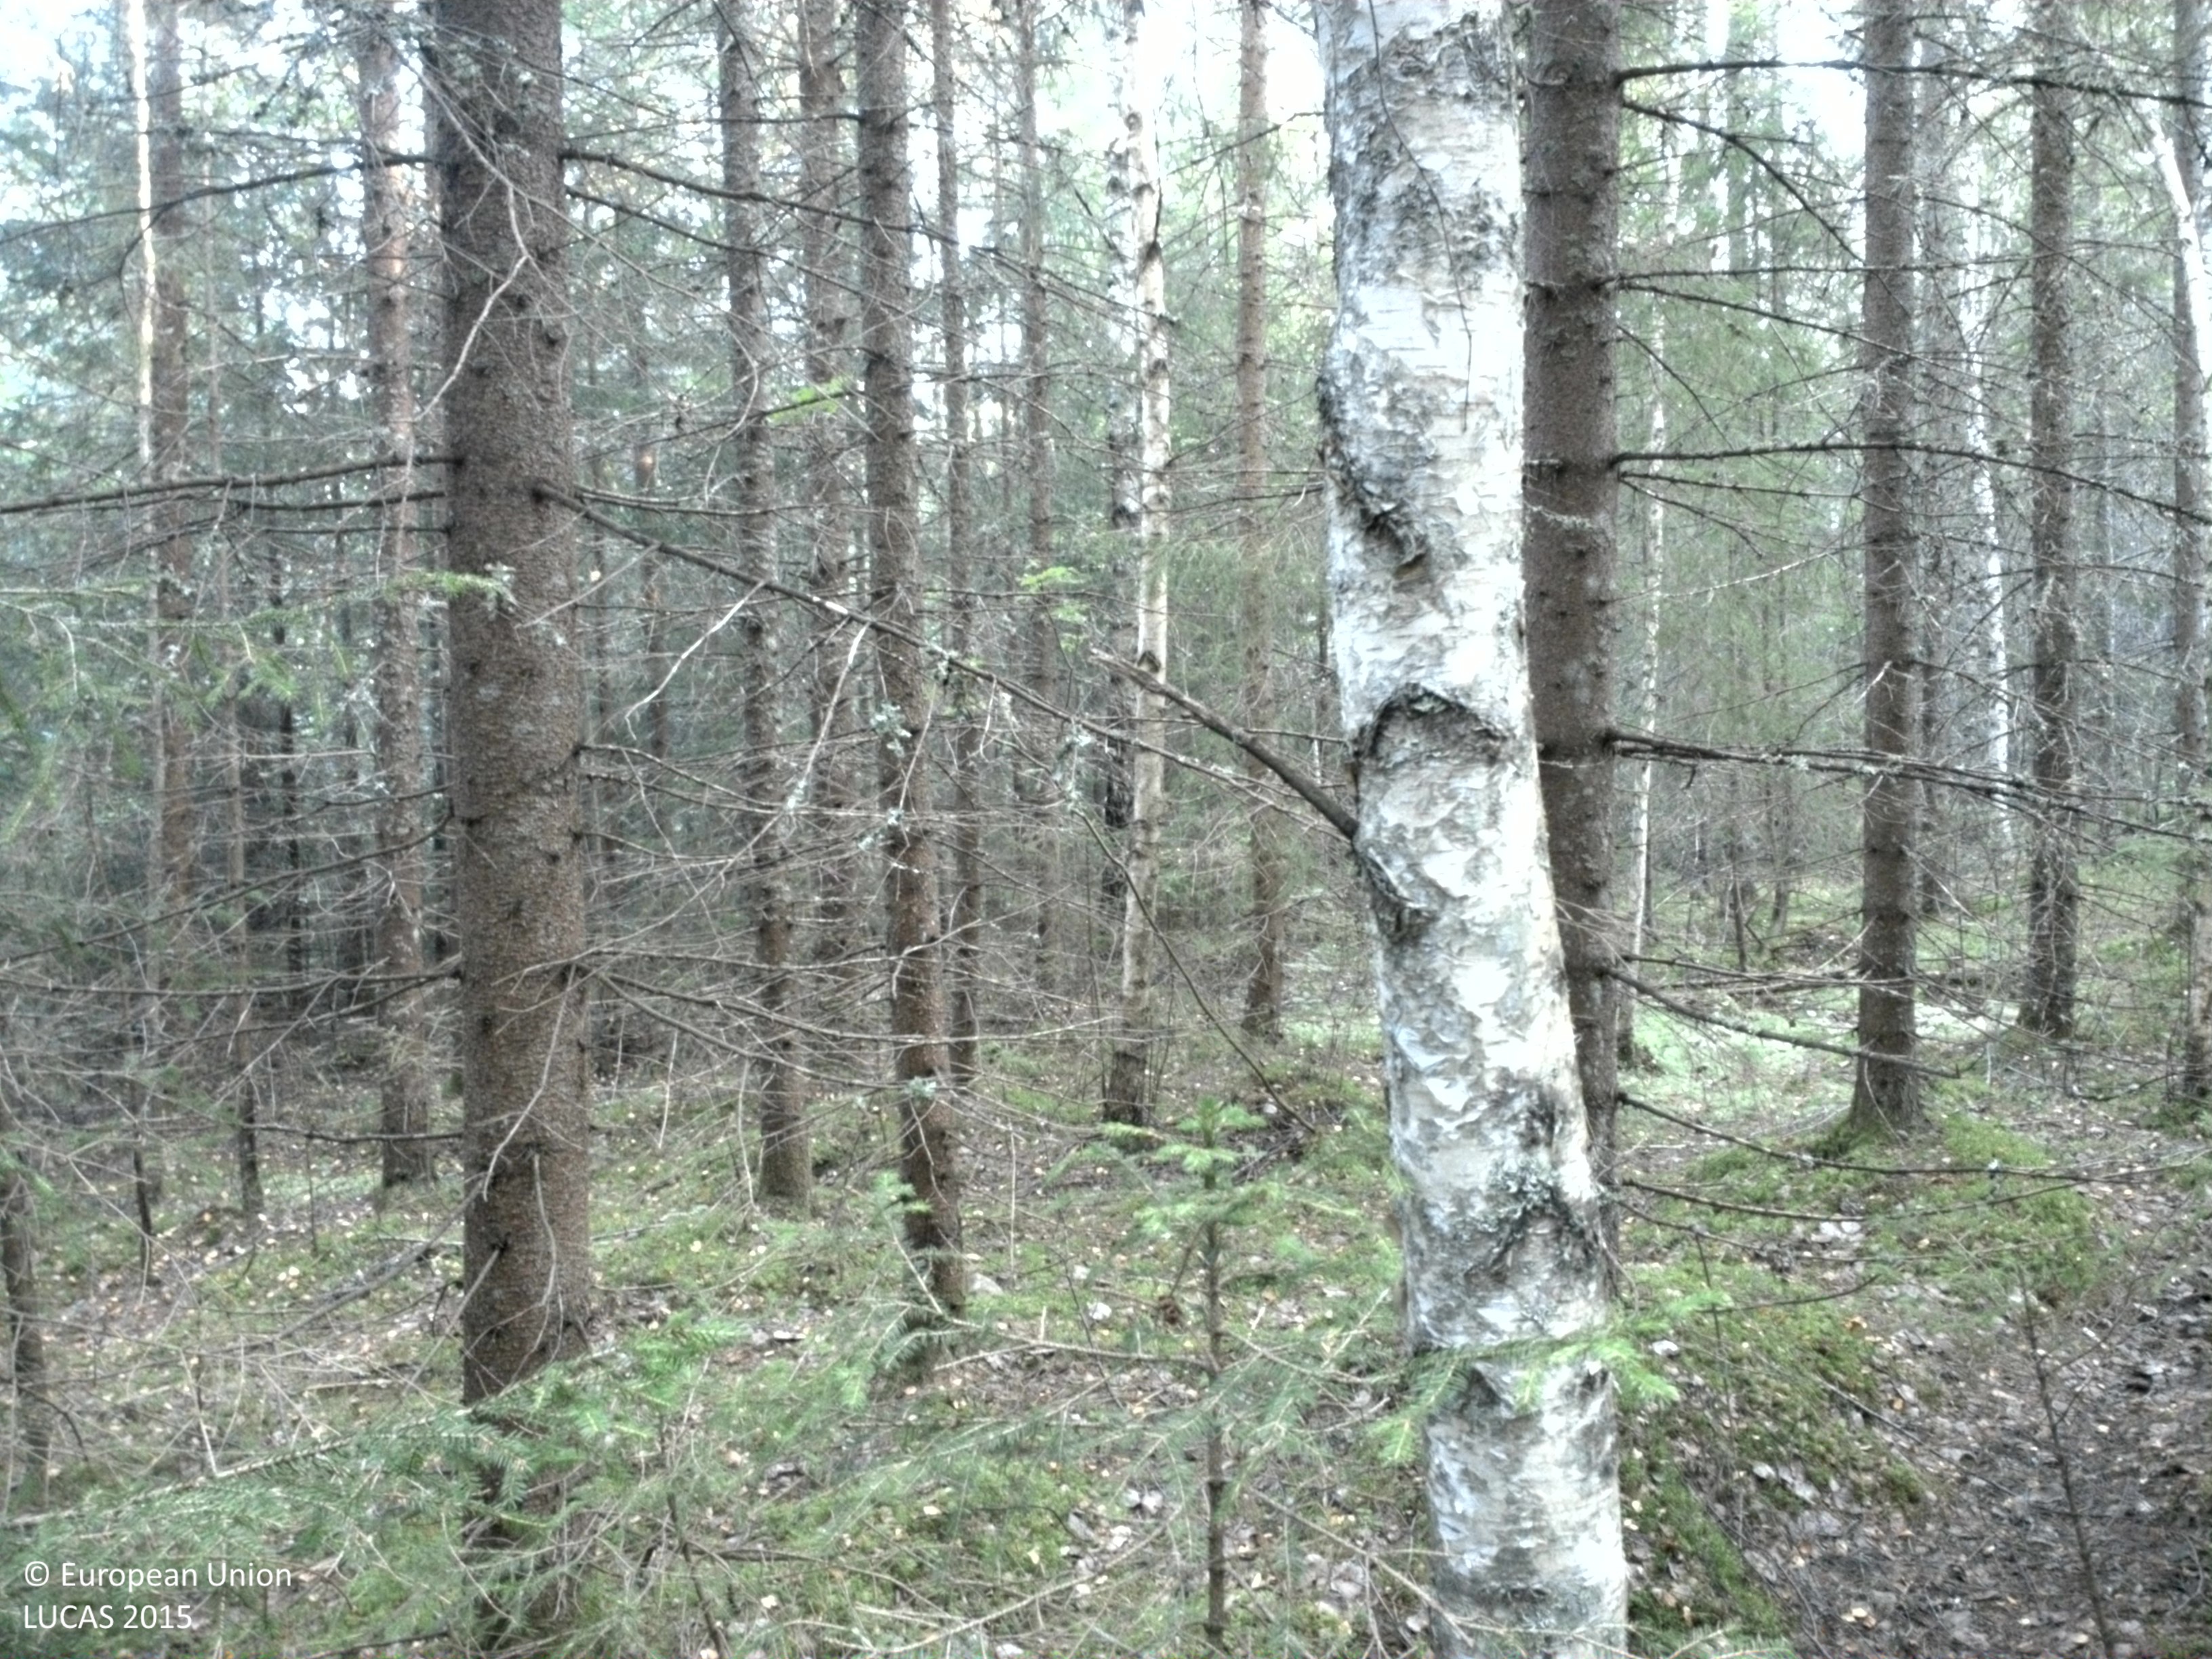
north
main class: Woodland
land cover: Spruce dominated coniferous woodland
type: boreal forest
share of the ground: 50 - 75 %
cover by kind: coniferous forest trees 65 %, lichens and mosses 20 %, broadleaved forest trees 5 %, shrubs 5 %, herbaceous plants 5 %
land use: Forestry
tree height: > 5 m
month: August
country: SE
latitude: 59.5459
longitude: 13.3704
